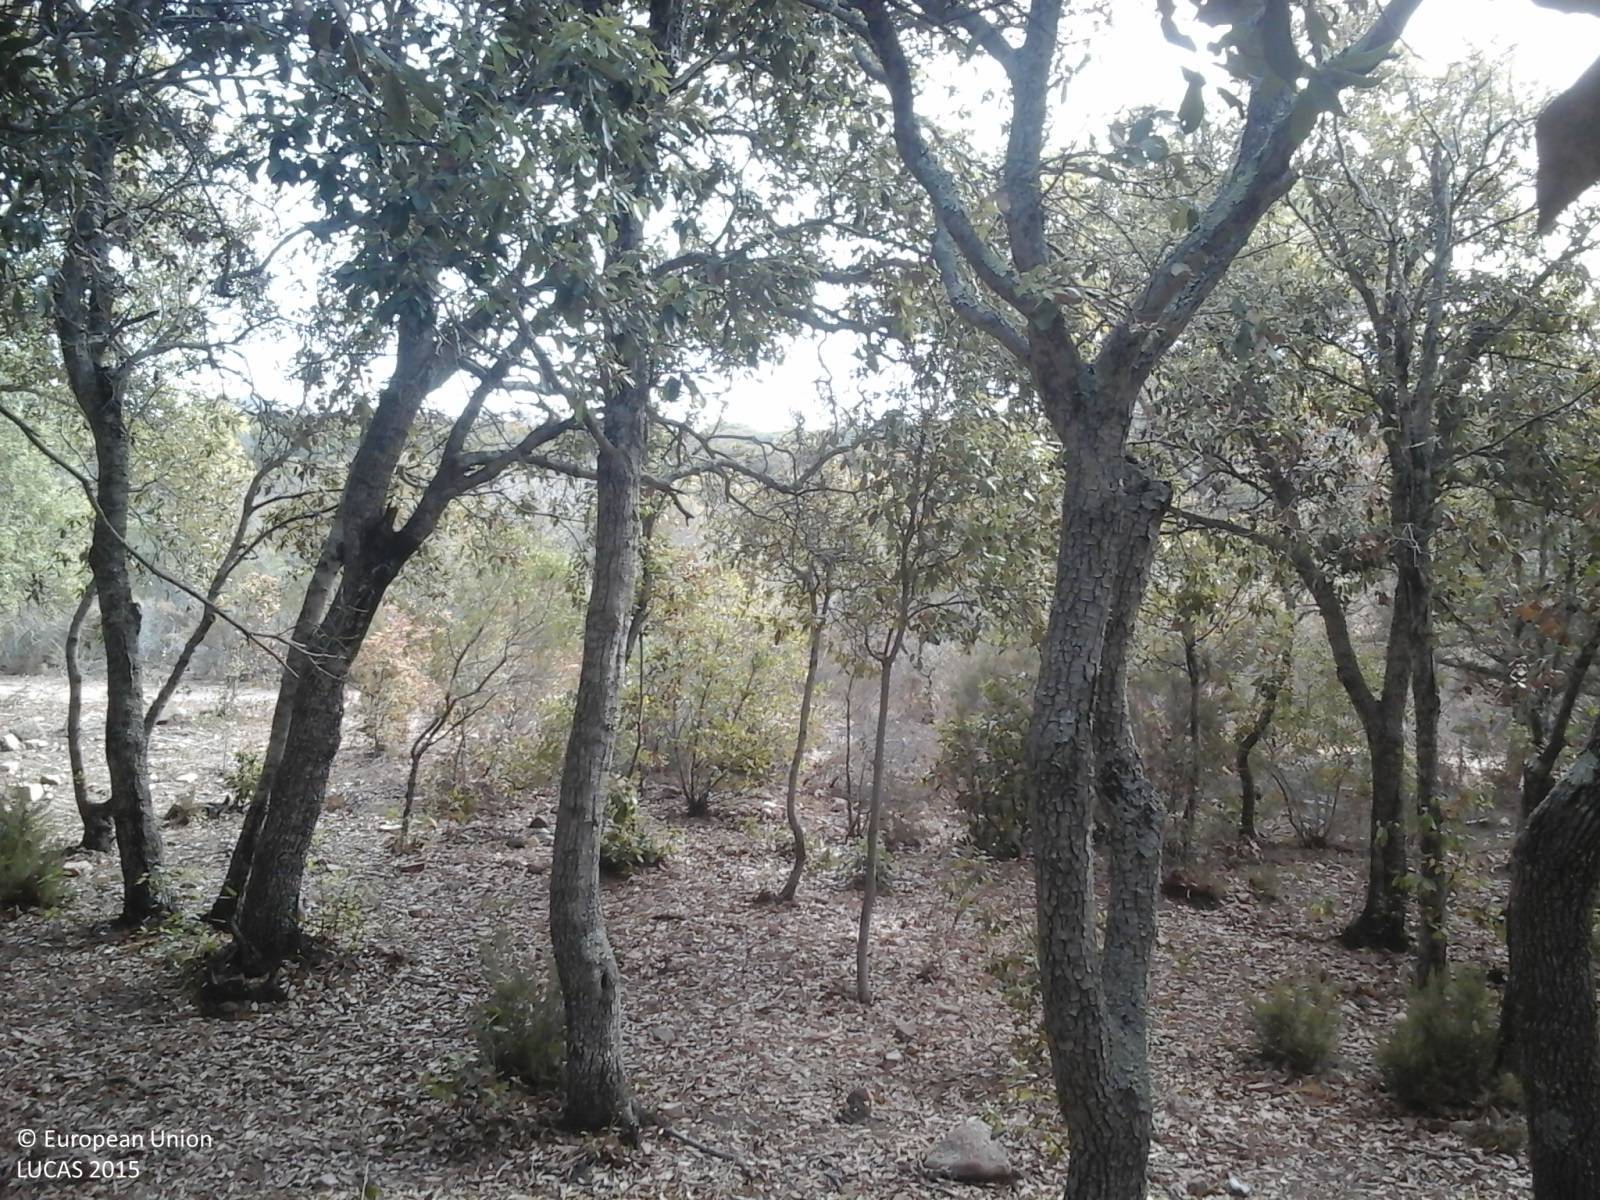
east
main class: Woodland
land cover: Broadleaved woodland
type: broadleaved evergreen forest
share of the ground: > 75 %
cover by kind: broadleaved forest trees 95 %, shrubs 5 %
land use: Semi-natural and natural areas not in use
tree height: > 5 m
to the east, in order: Broadleaved woodland; Tracks; Broadleaved woodland; Shrubland with sparse tree cover; Broadleaved woodland; Paved roads, cycling and walking lanes; Broadleaved woodland
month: September
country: IT
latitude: 41.2068
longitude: 9.4657
